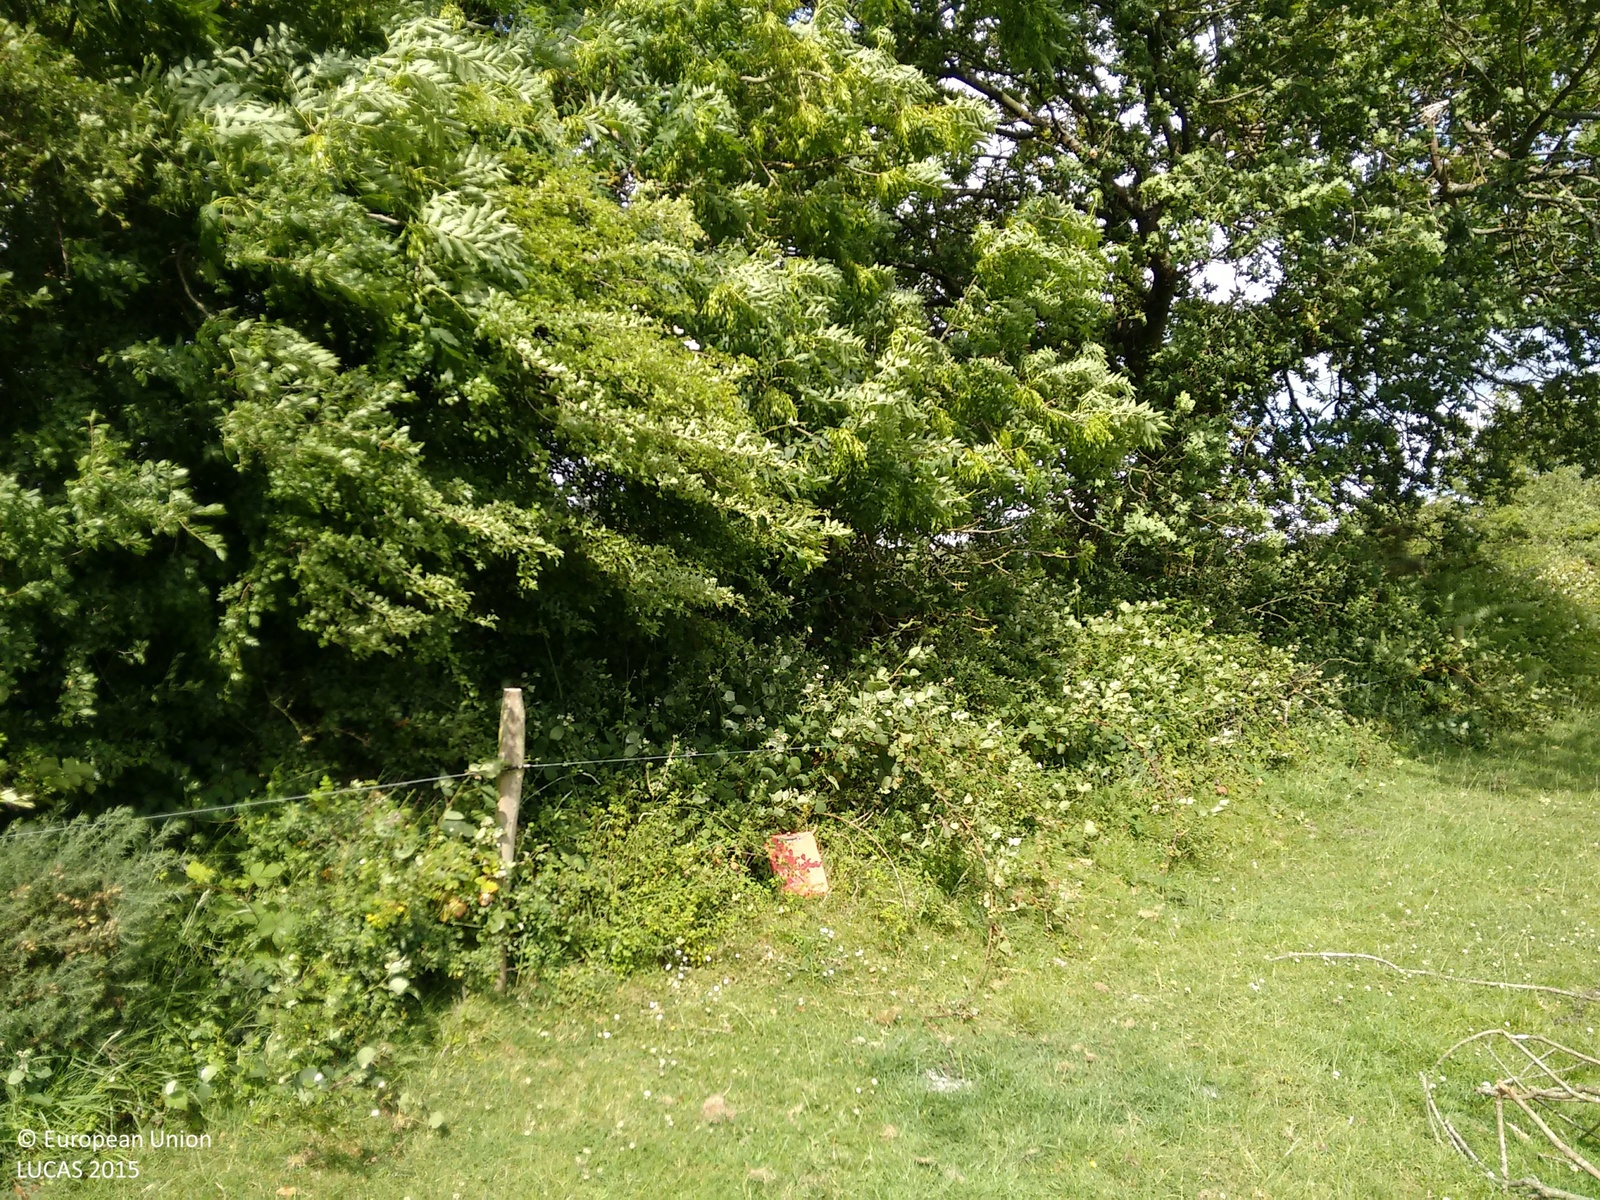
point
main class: Grassland
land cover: Grassland without tree/shrub cover
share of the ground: > 75 %
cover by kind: herbaceous plants 100 %
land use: Agriculture (excluding fallow land and kitchen gardens)
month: July
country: IE
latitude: 52.5348
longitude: -7.6332
